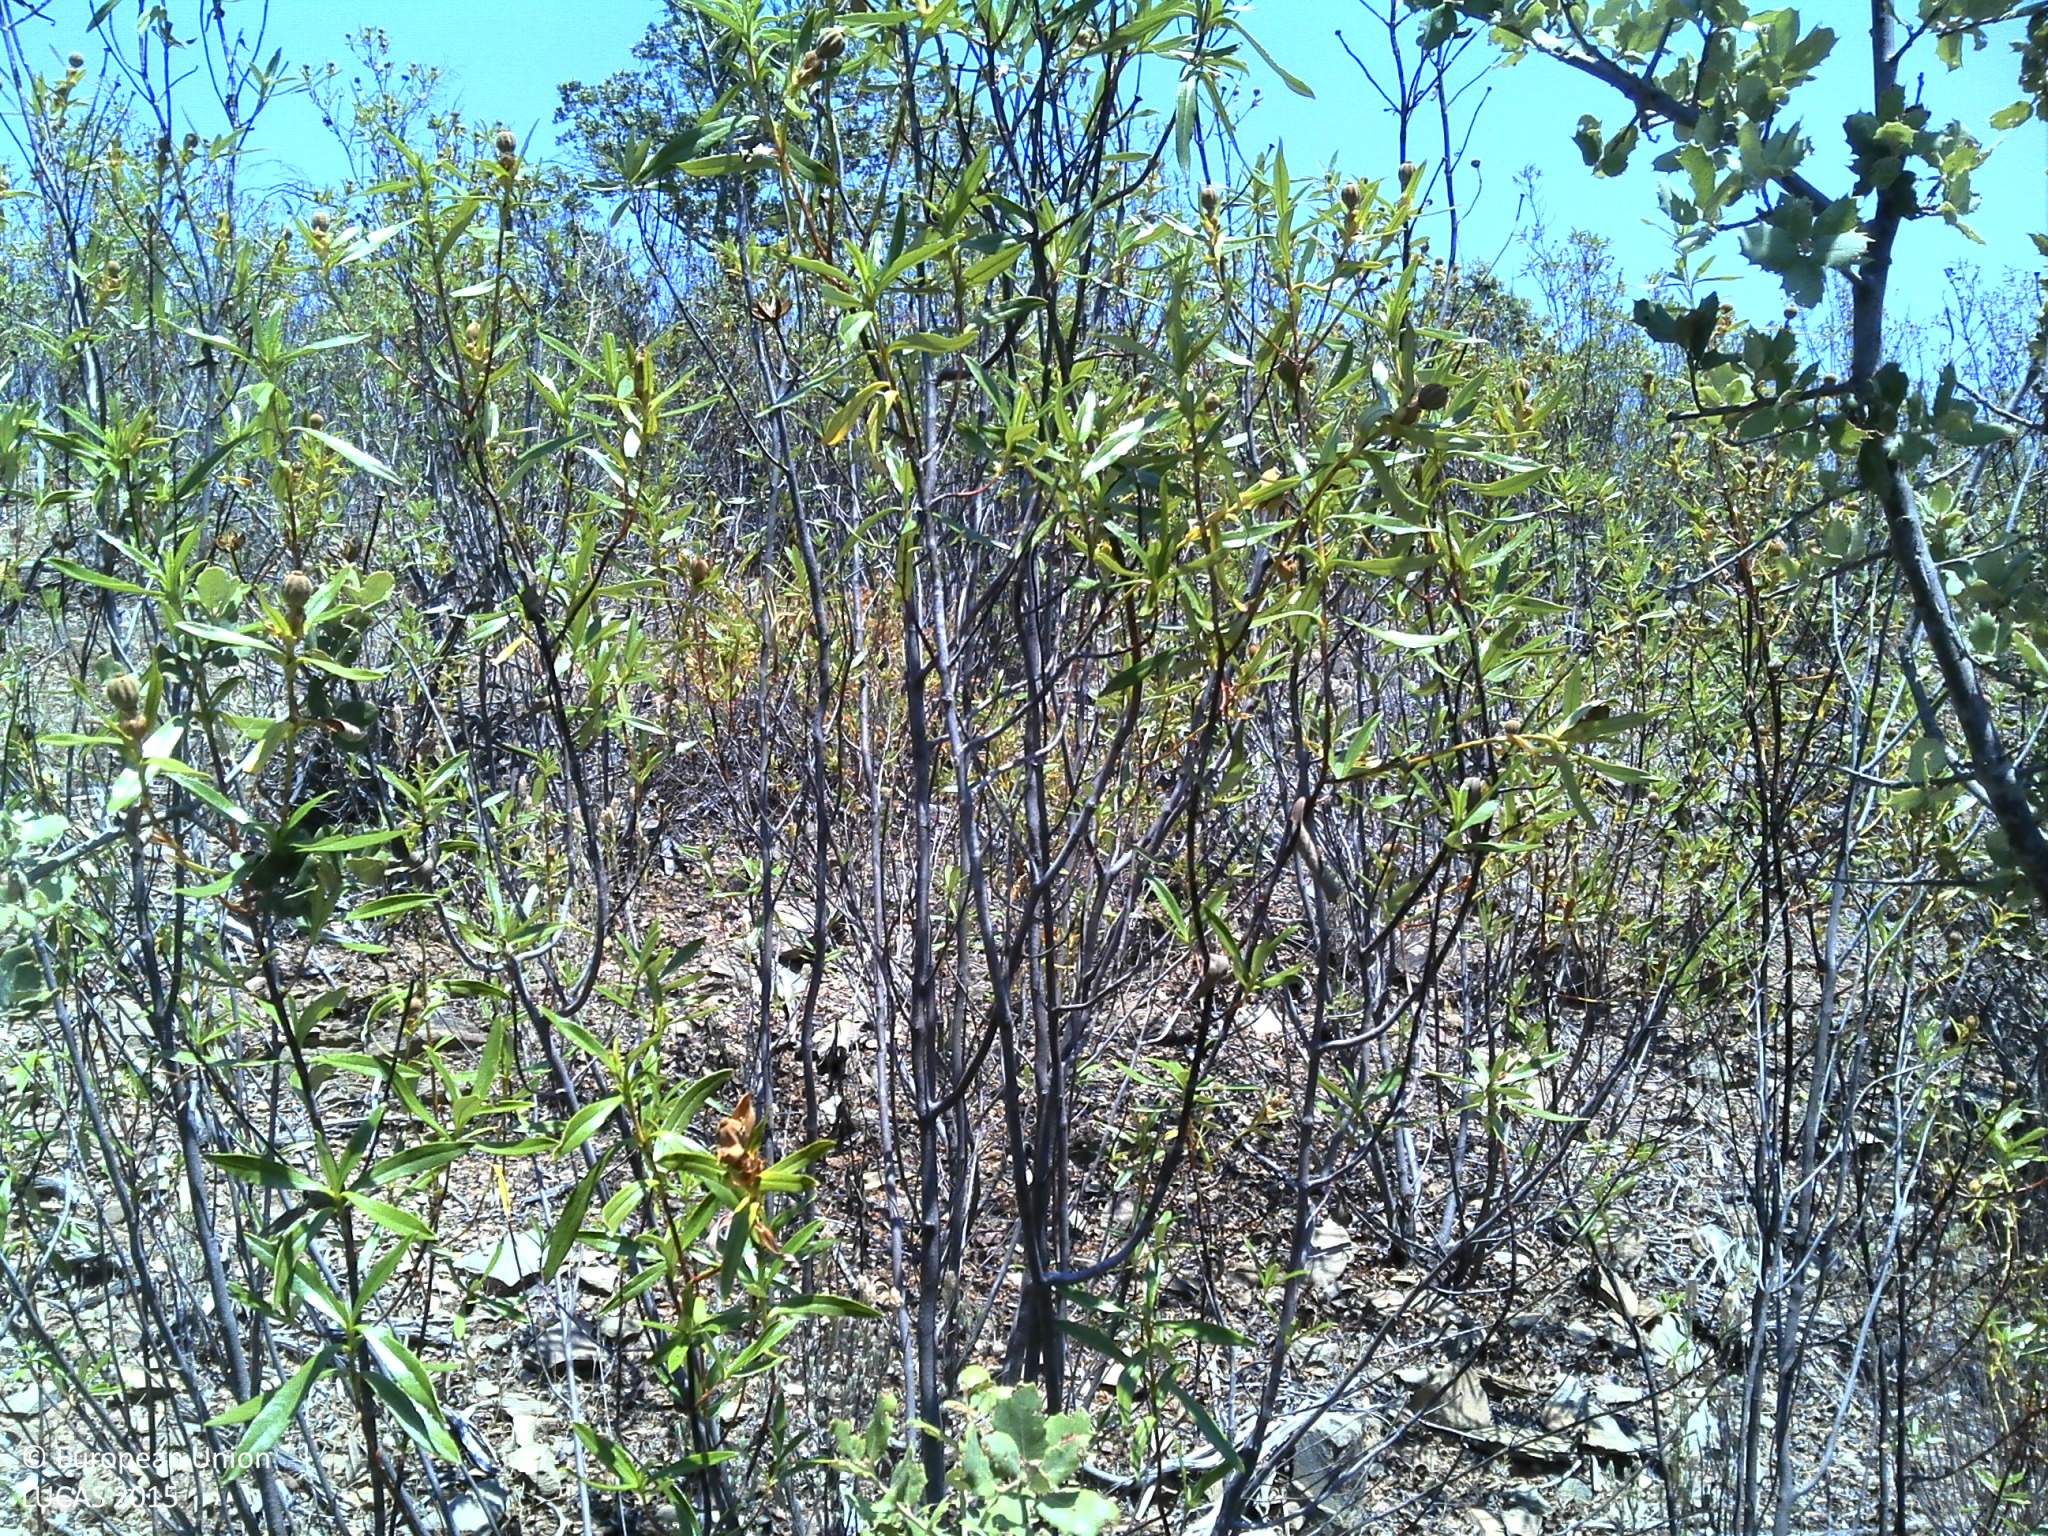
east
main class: Shrubland
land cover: Shrubland without tree cover
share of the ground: > 75 %
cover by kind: shrubs 100 %
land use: Abandoned areas
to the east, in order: Shrubland without tree cover; Shrubland with sparse tree cover; Grassland without tree/shrub cover; Grassland with sparse tree/shrub cover; Grassland without tree/shrub cover; Grassland with sparse tree/shrub cover
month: June
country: PT
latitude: 37.4040
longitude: -7.8994
